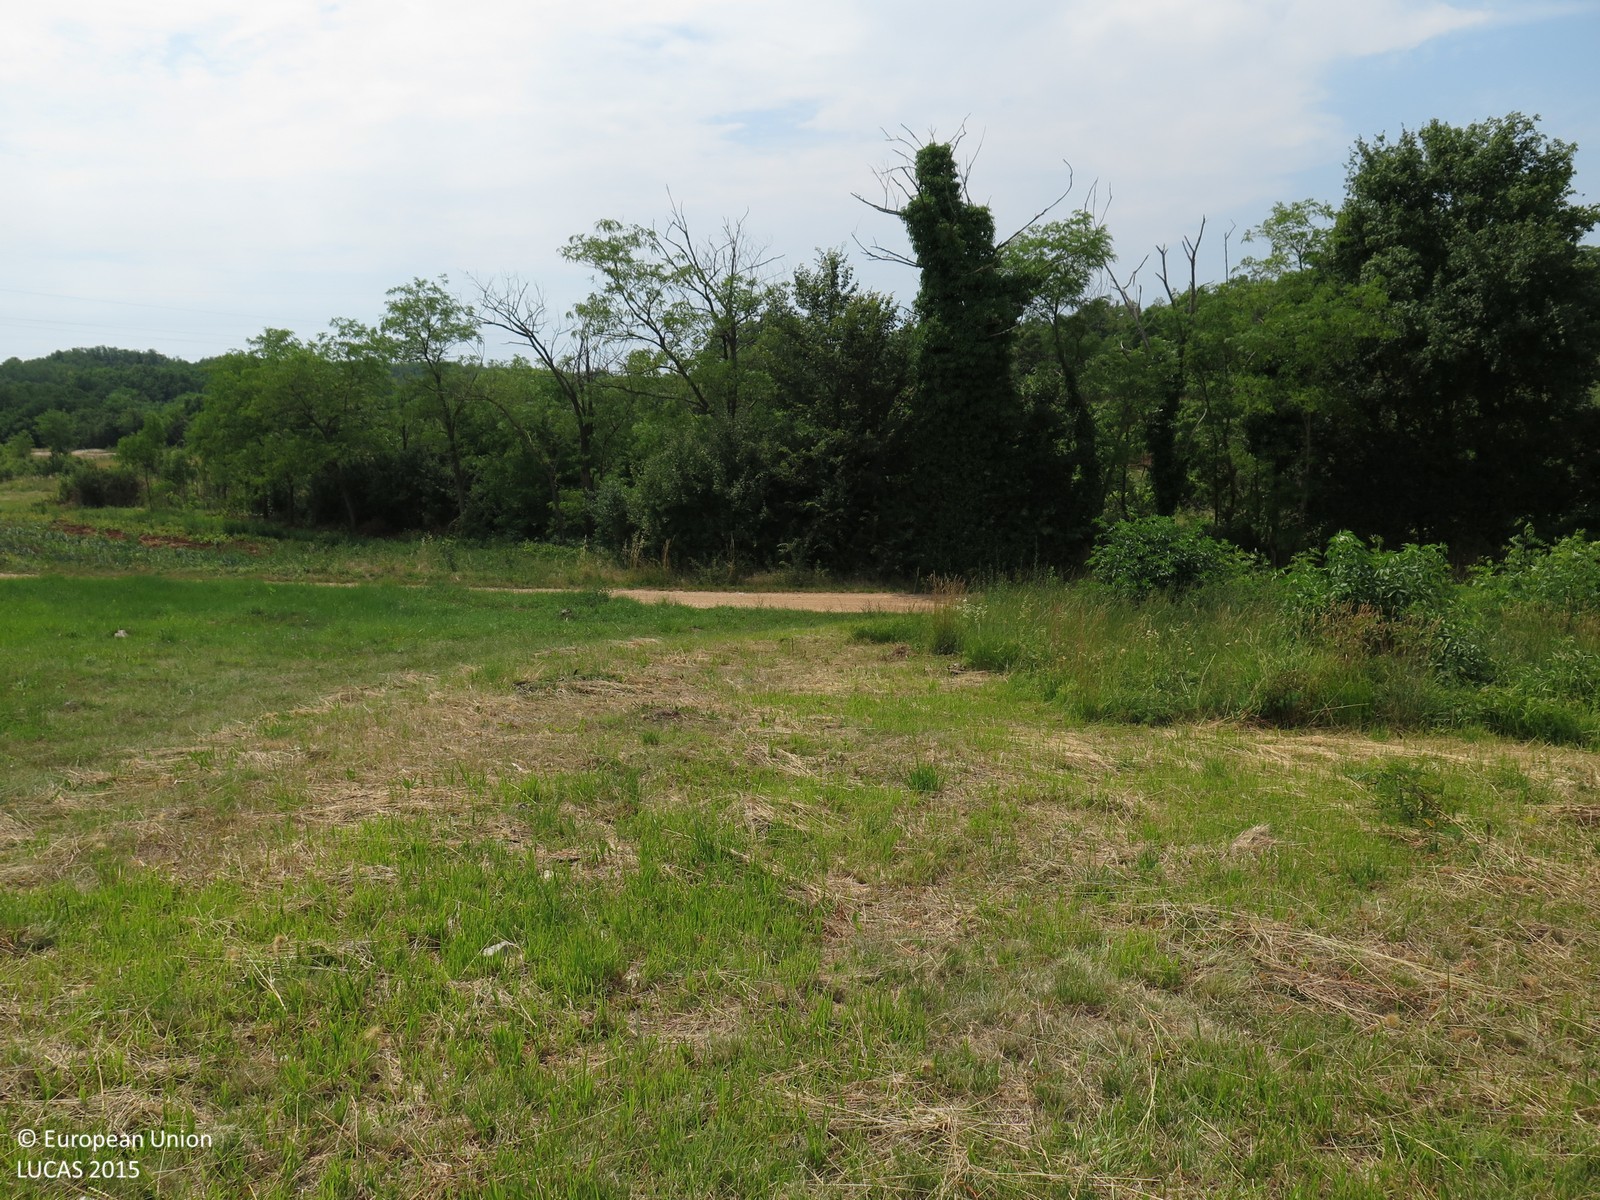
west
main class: Grassland
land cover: Grassland without tree/shrub cover
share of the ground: > 75 %
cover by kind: herbaceous plants 100 %
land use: Residential
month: June
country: HR
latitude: 45.2905
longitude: 13.8328
